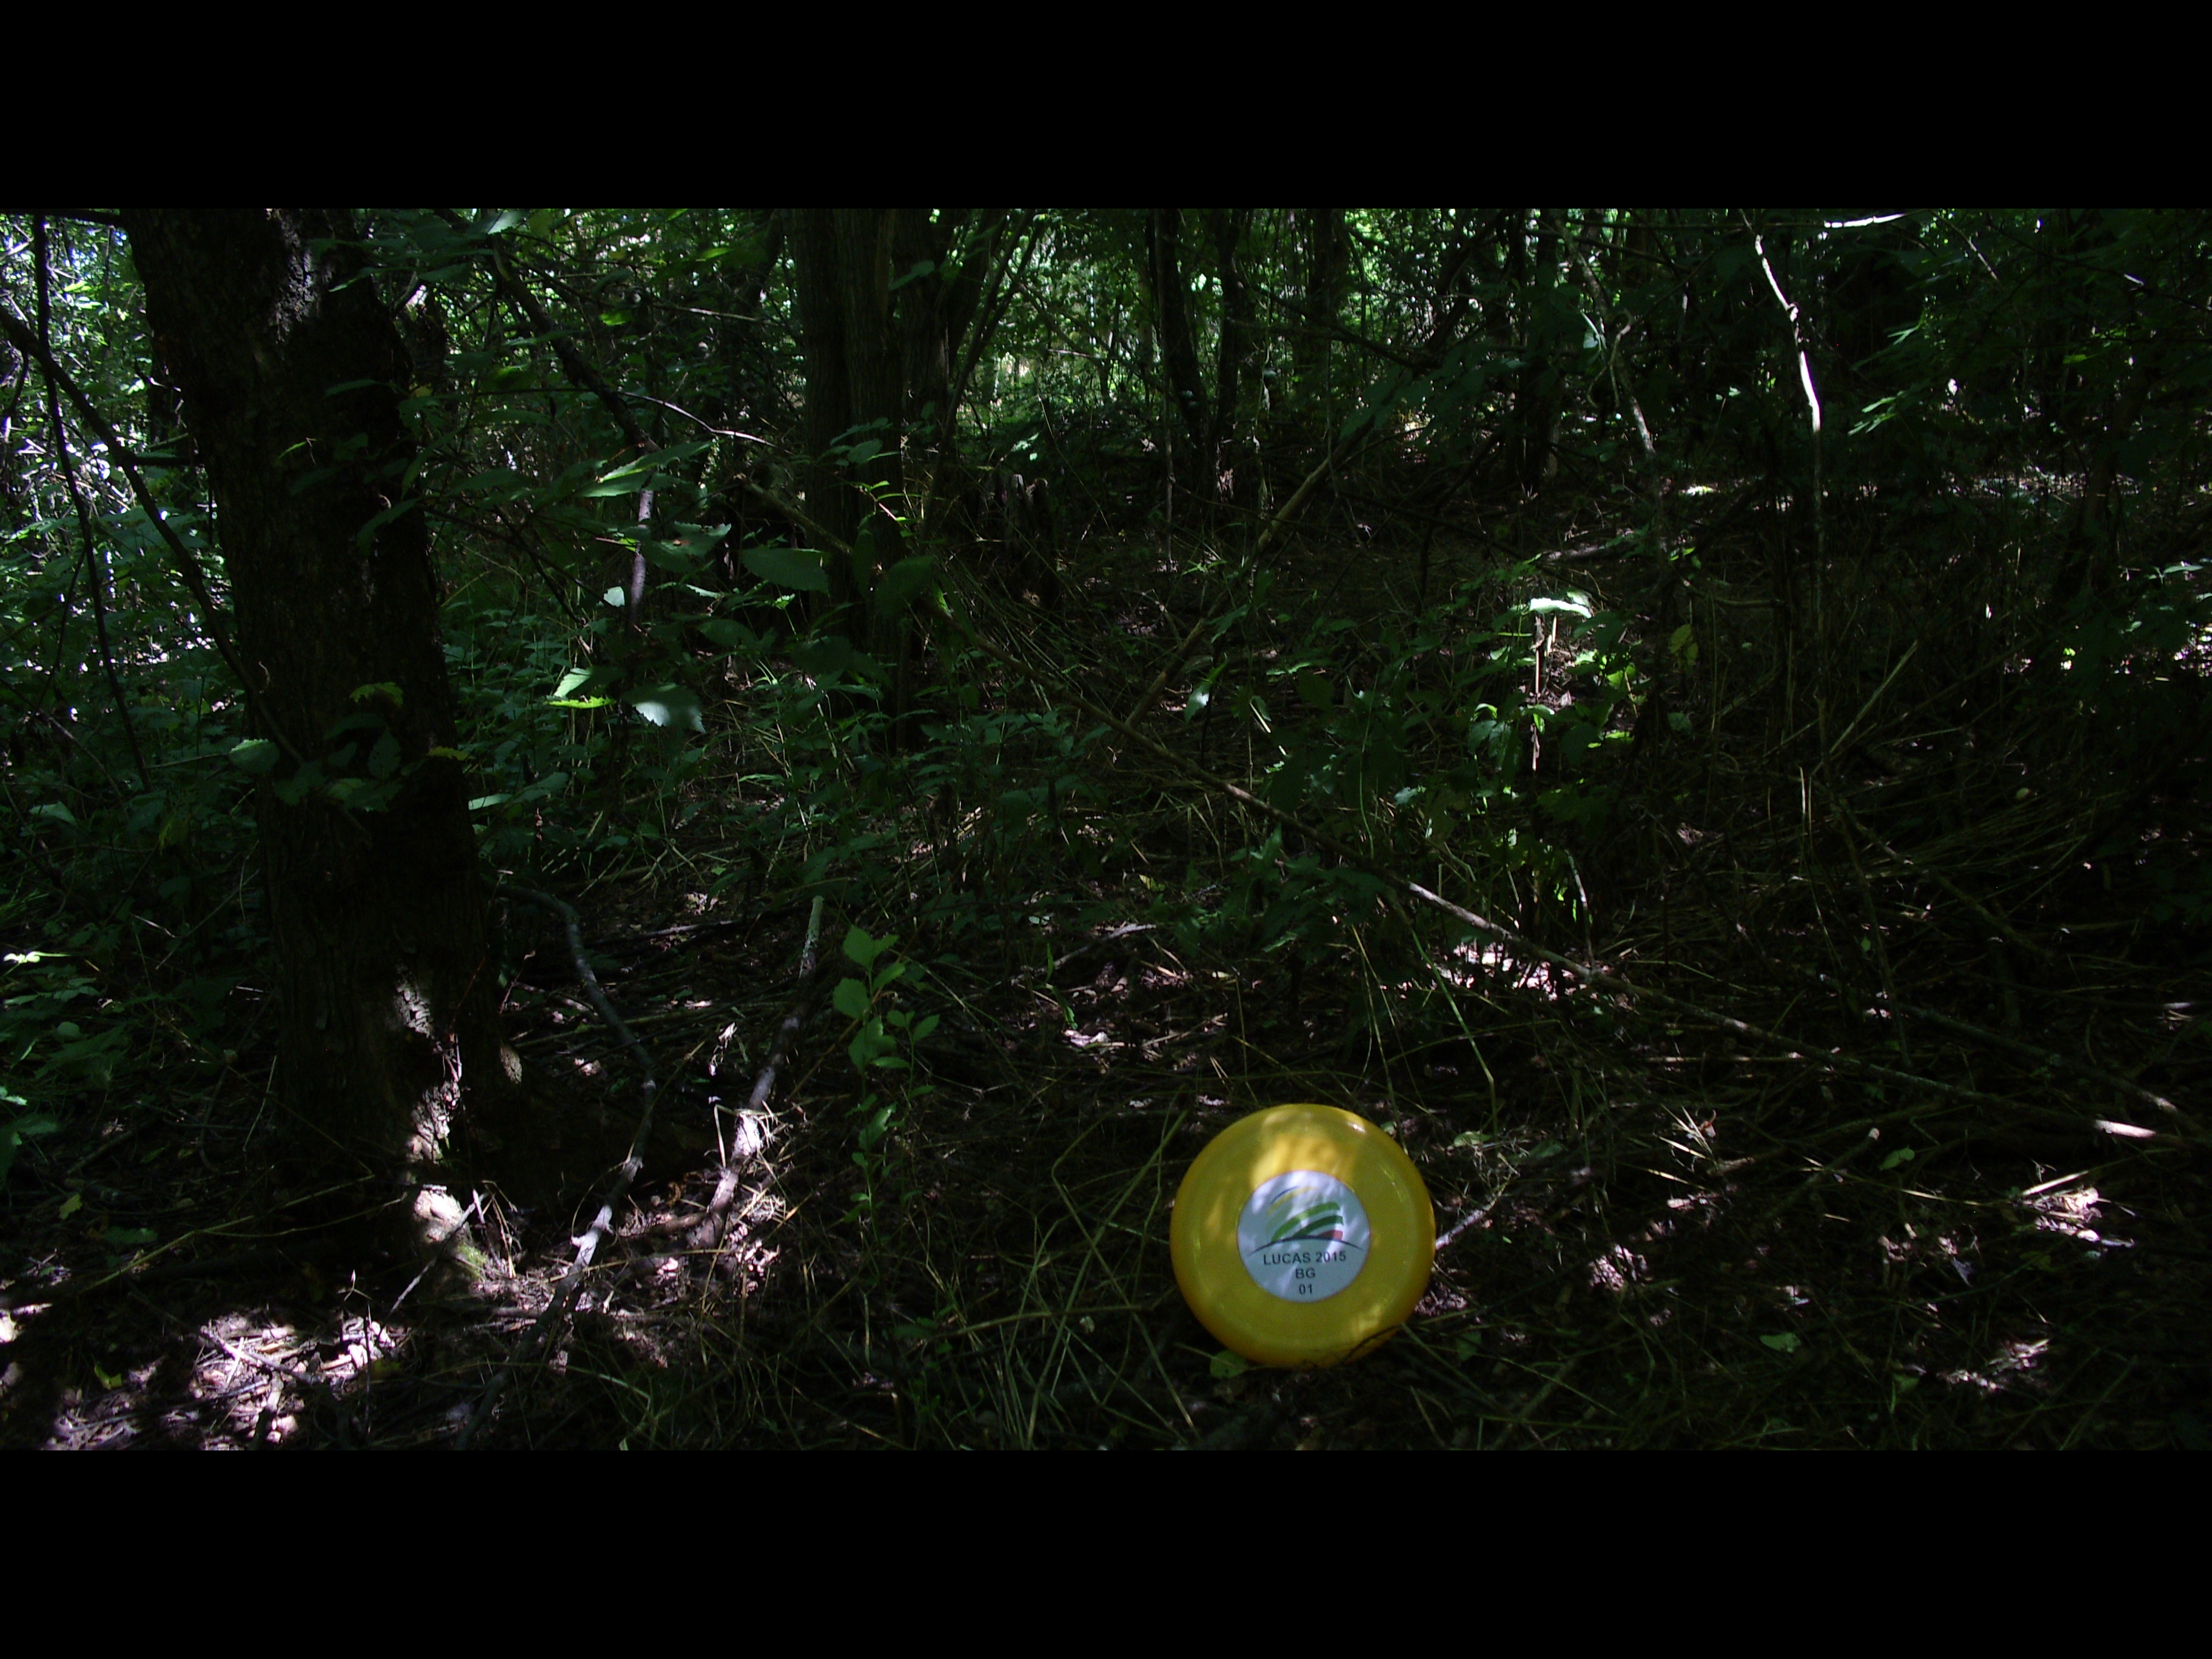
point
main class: Woodland
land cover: Broadleaved woodland
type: mesophytic deciduous forest
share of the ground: > 75 %
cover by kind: broadleaved forest trees 95 %, shrubs 5 %
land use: Forestry
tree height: > 5 m
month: June
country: BG
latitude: 43.6207
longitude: 23.6926
